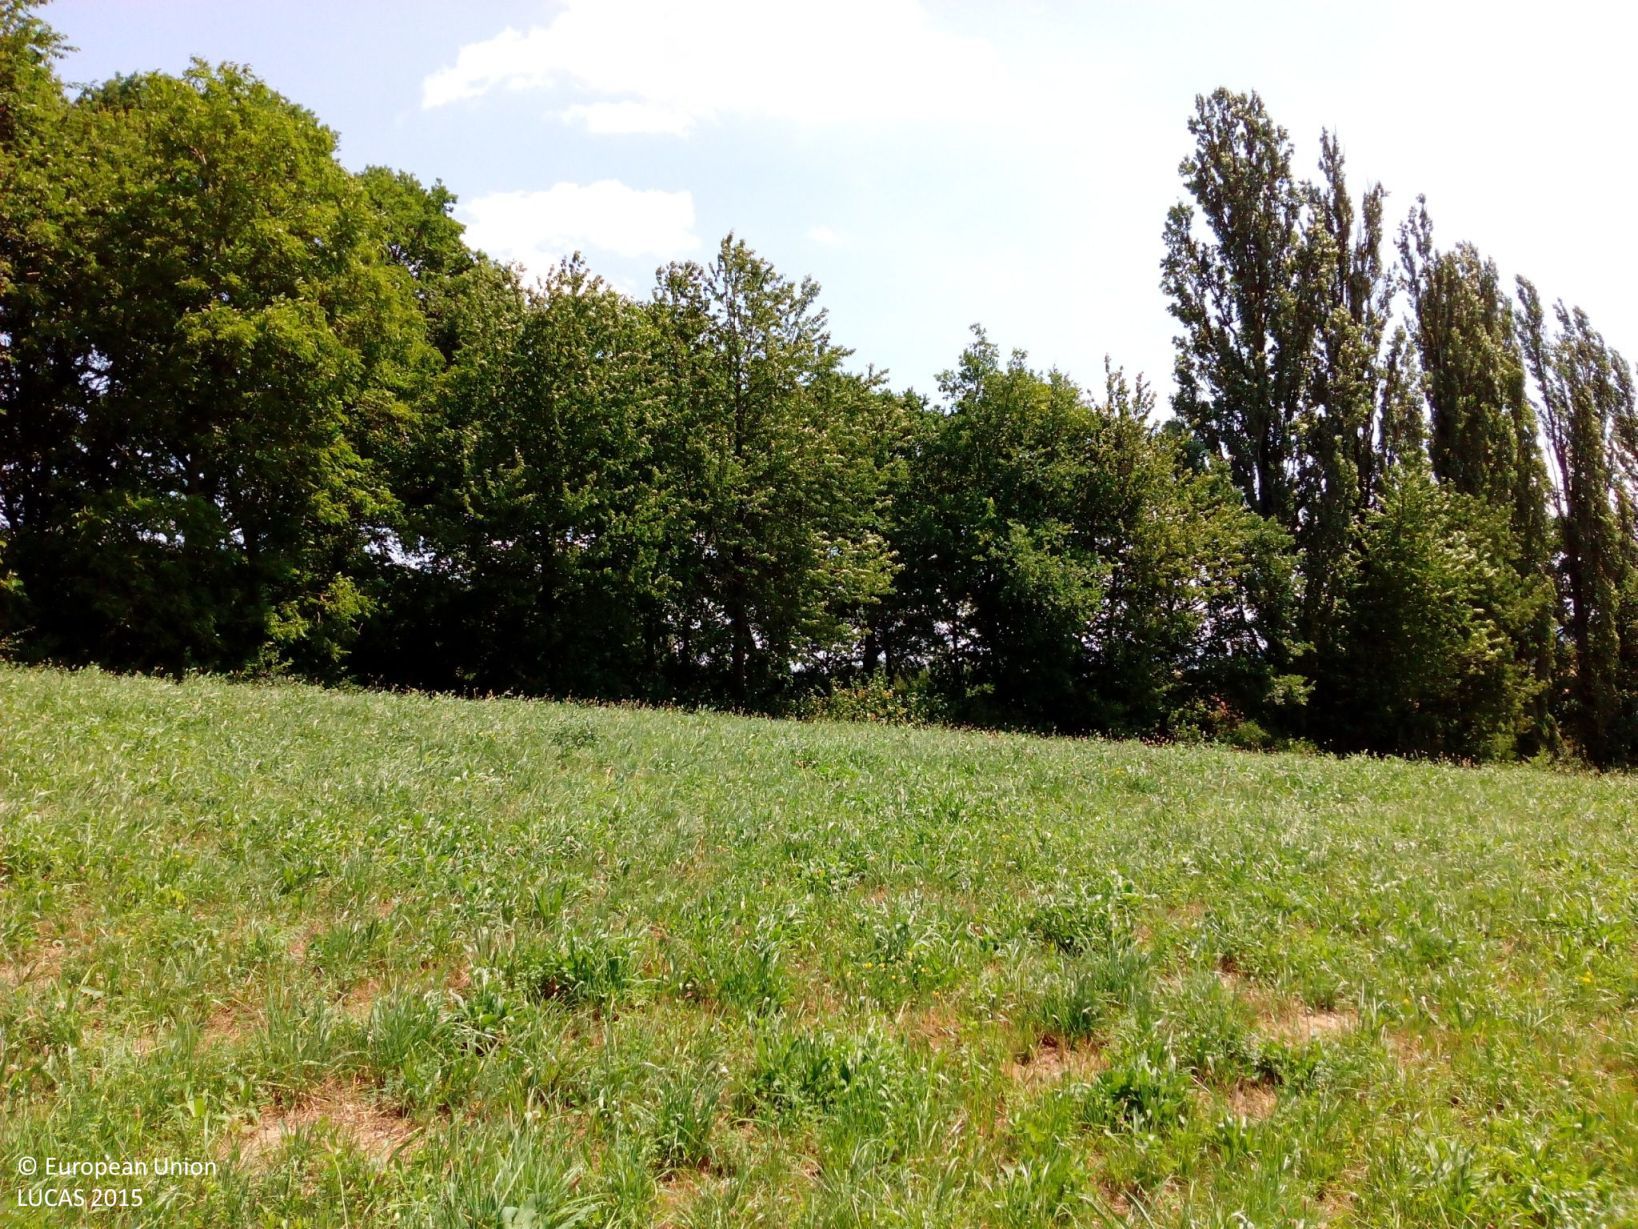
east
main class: Grassland
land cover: Grassland without tree/shrub cover
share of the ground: > 75 %
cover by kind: herbaceous plants 95 %, unconsolidated bare surface 5 %
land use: Agriculture (excluding fallow land and kitchen gardens)
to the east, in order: Grassland without tree/shrub cover; Shruby margins; Ditches and canals; Broadleaved woodland; Paved roads, cycling and walking lanes; Ditches and canals; Shruby margins; Broadleaved woodland; Grassland without tree/shrub cover; Maize; Shruby margins; Grass margins; Tracks; Grass margins; Fences; Shruby margins; Grassland without tree/shrub cover; Cherry fruit; Electric lines; Grassland without tree/shrub cover; Artificial constructions in urban areas
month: July
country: DE
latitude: 47.6384
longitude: 8.5769
